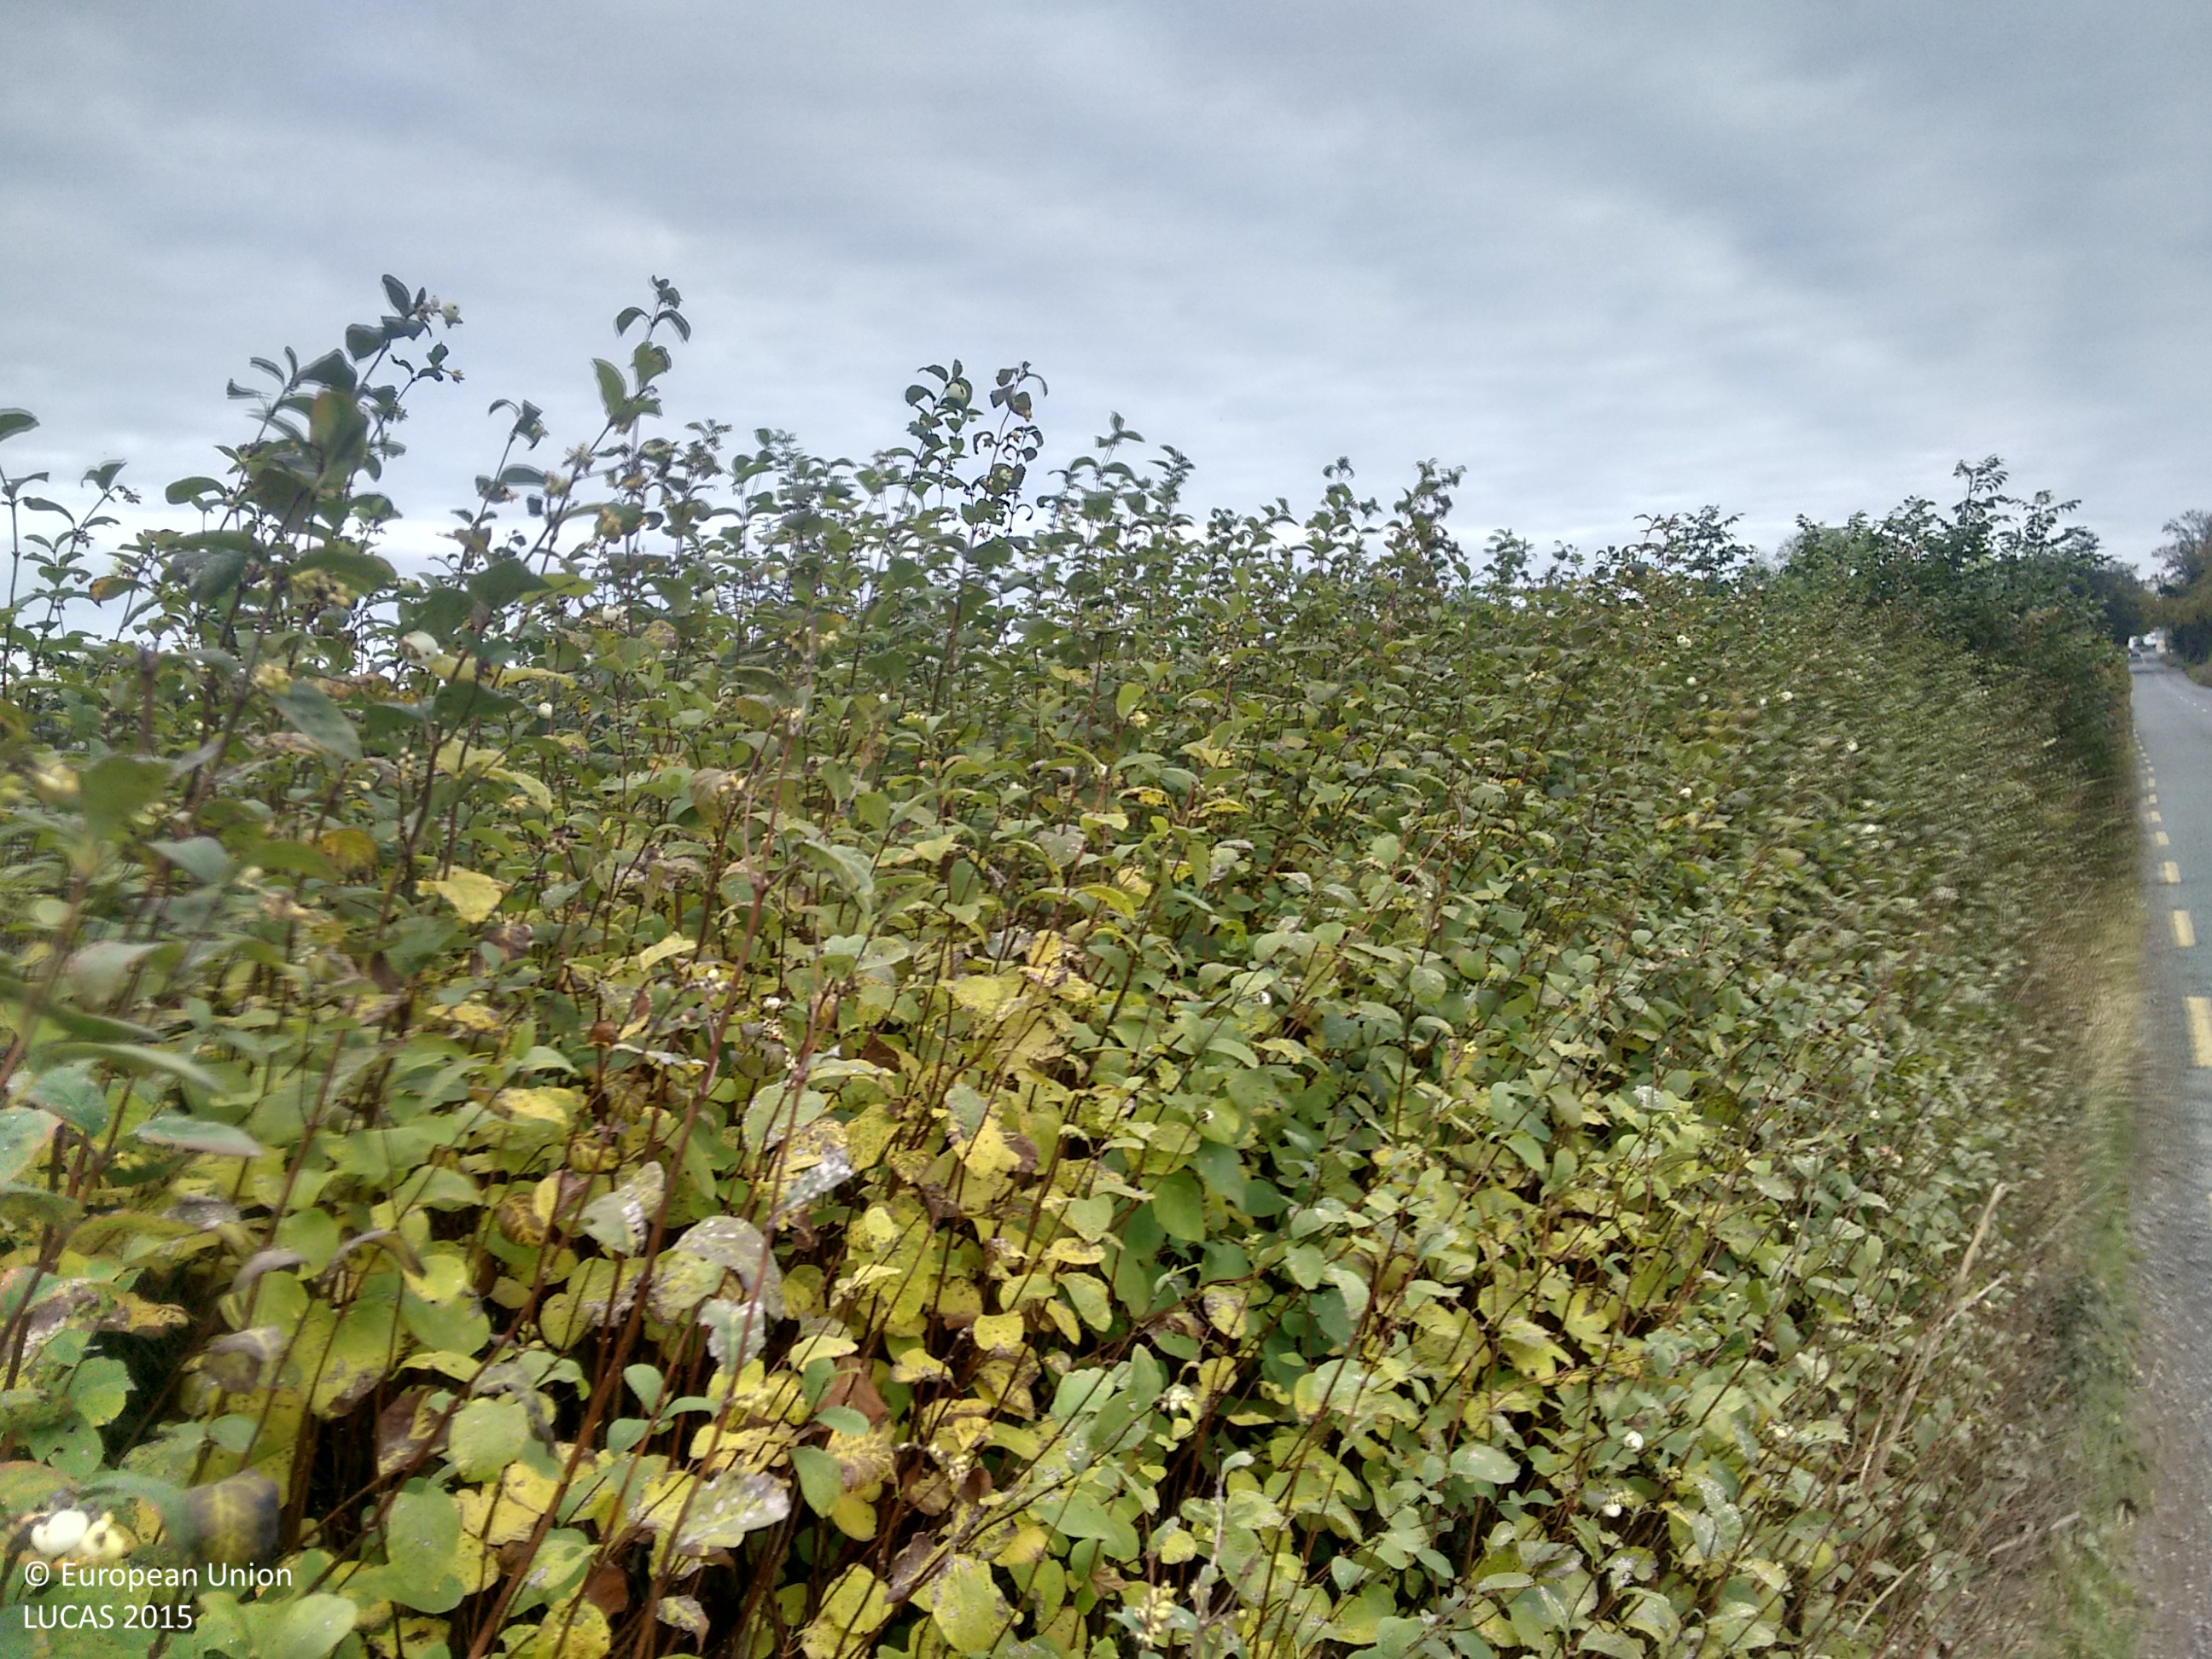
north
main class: Grassland
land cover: Grassland without tree/shrub cover
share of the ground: > 75 %
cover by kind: herbaceous plants 75 %, consolidated bare surface 20 %, shrubs 5 %
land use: Agriculture (excluding fallow land and kitchen gardens)
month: October
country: IE
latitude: 52.8732
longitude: -7.4661
